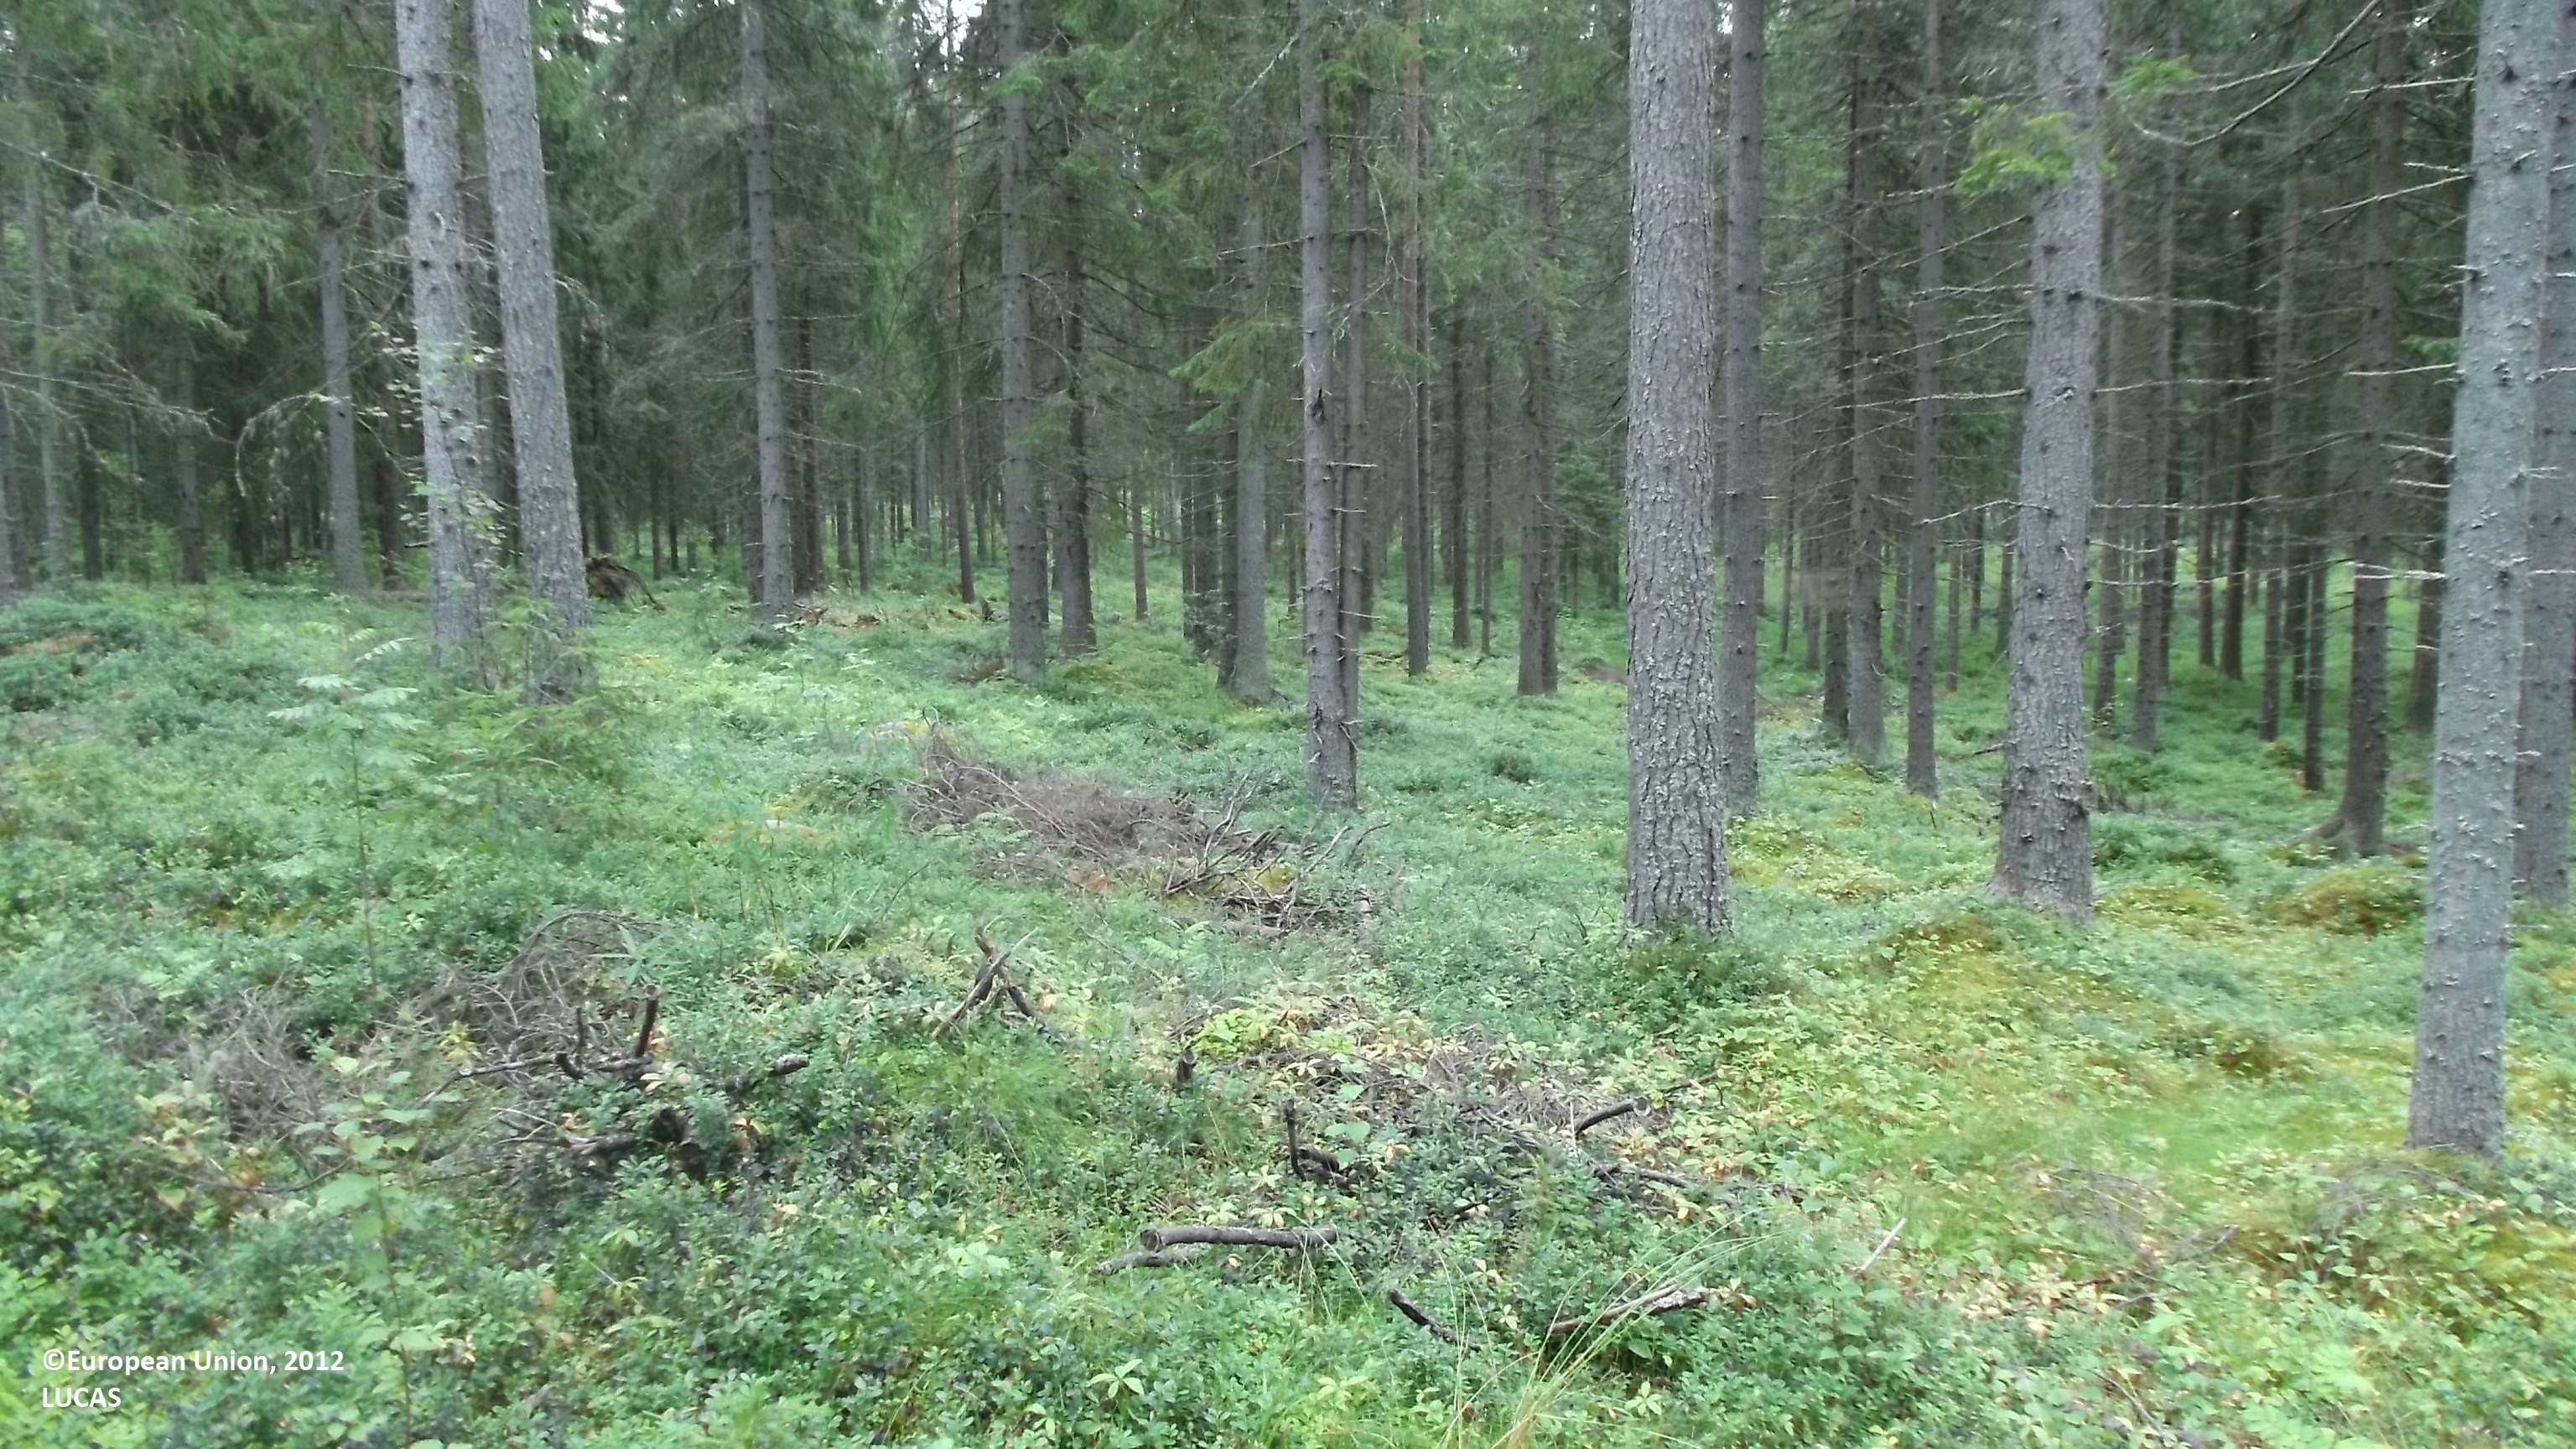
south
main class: Woodland
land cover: Other mixed woodland
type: boreal forest
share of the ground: 25 - 50 %
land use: Forestry
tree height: > 5 m
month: August
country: FI
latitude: 63.9285
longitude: 23.4972
